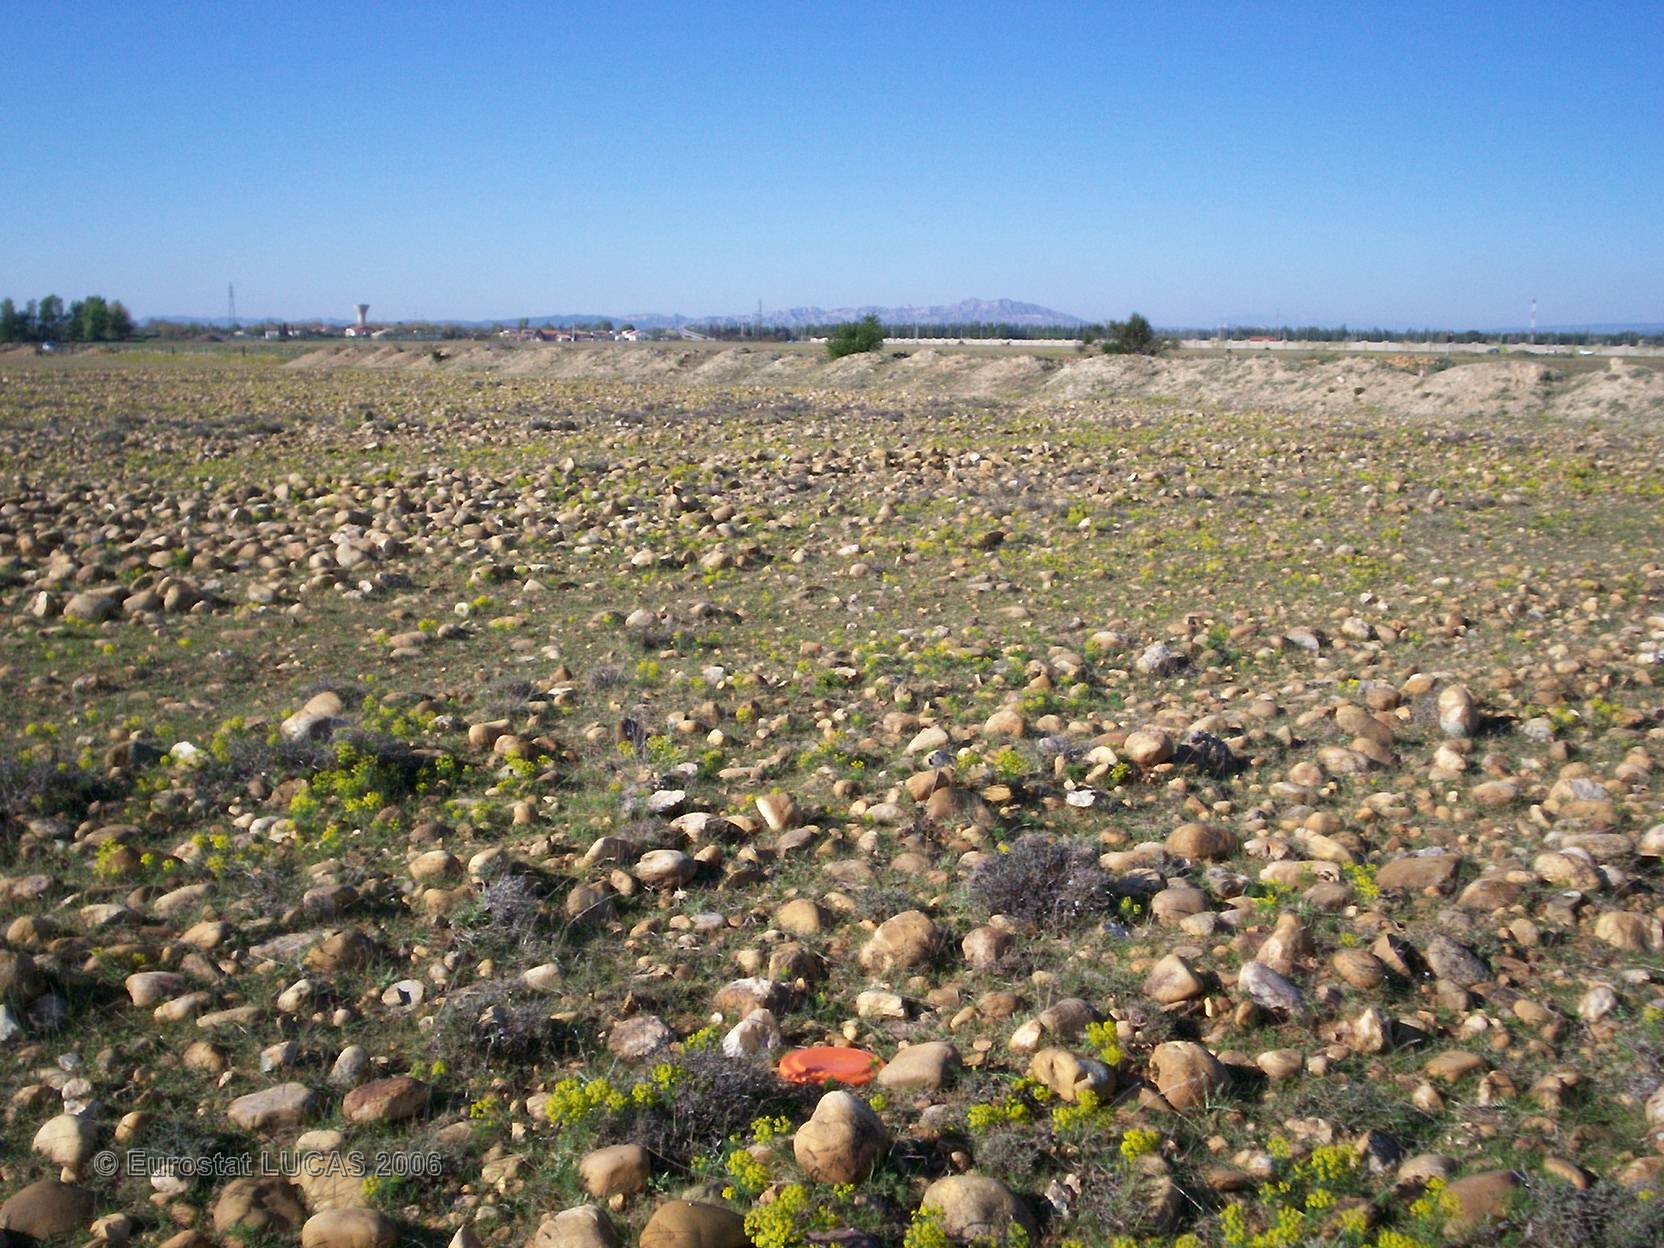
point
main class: Bare land
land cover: Bare land
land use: Unused
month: April
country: FR
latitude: 43.5767
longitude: 4.9450
